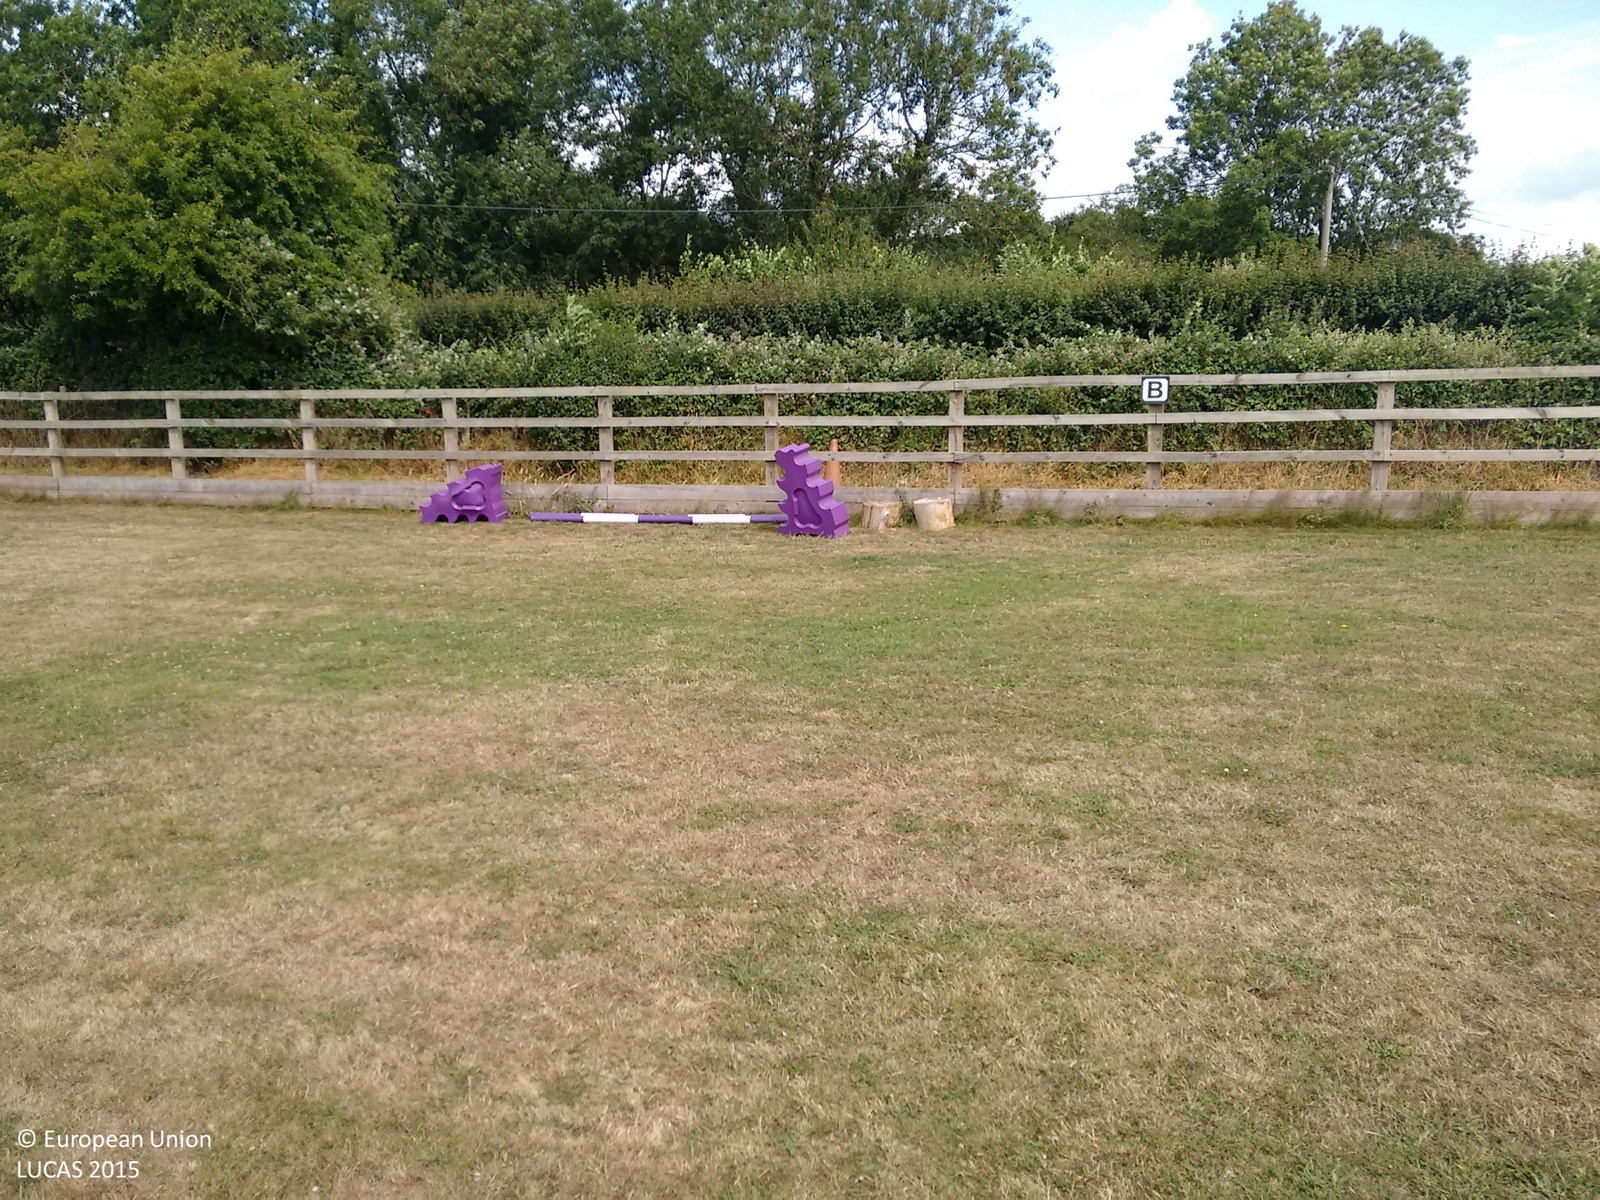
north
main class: Grassland
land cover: Grassland without tree/shrub cover
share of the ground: > 75 %
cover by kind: herbaceous plants 100 %
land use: Agriculture (excluding fallow land and kitchen gardens)
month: July
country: GB
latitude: 51.0840
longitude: -0.4157
